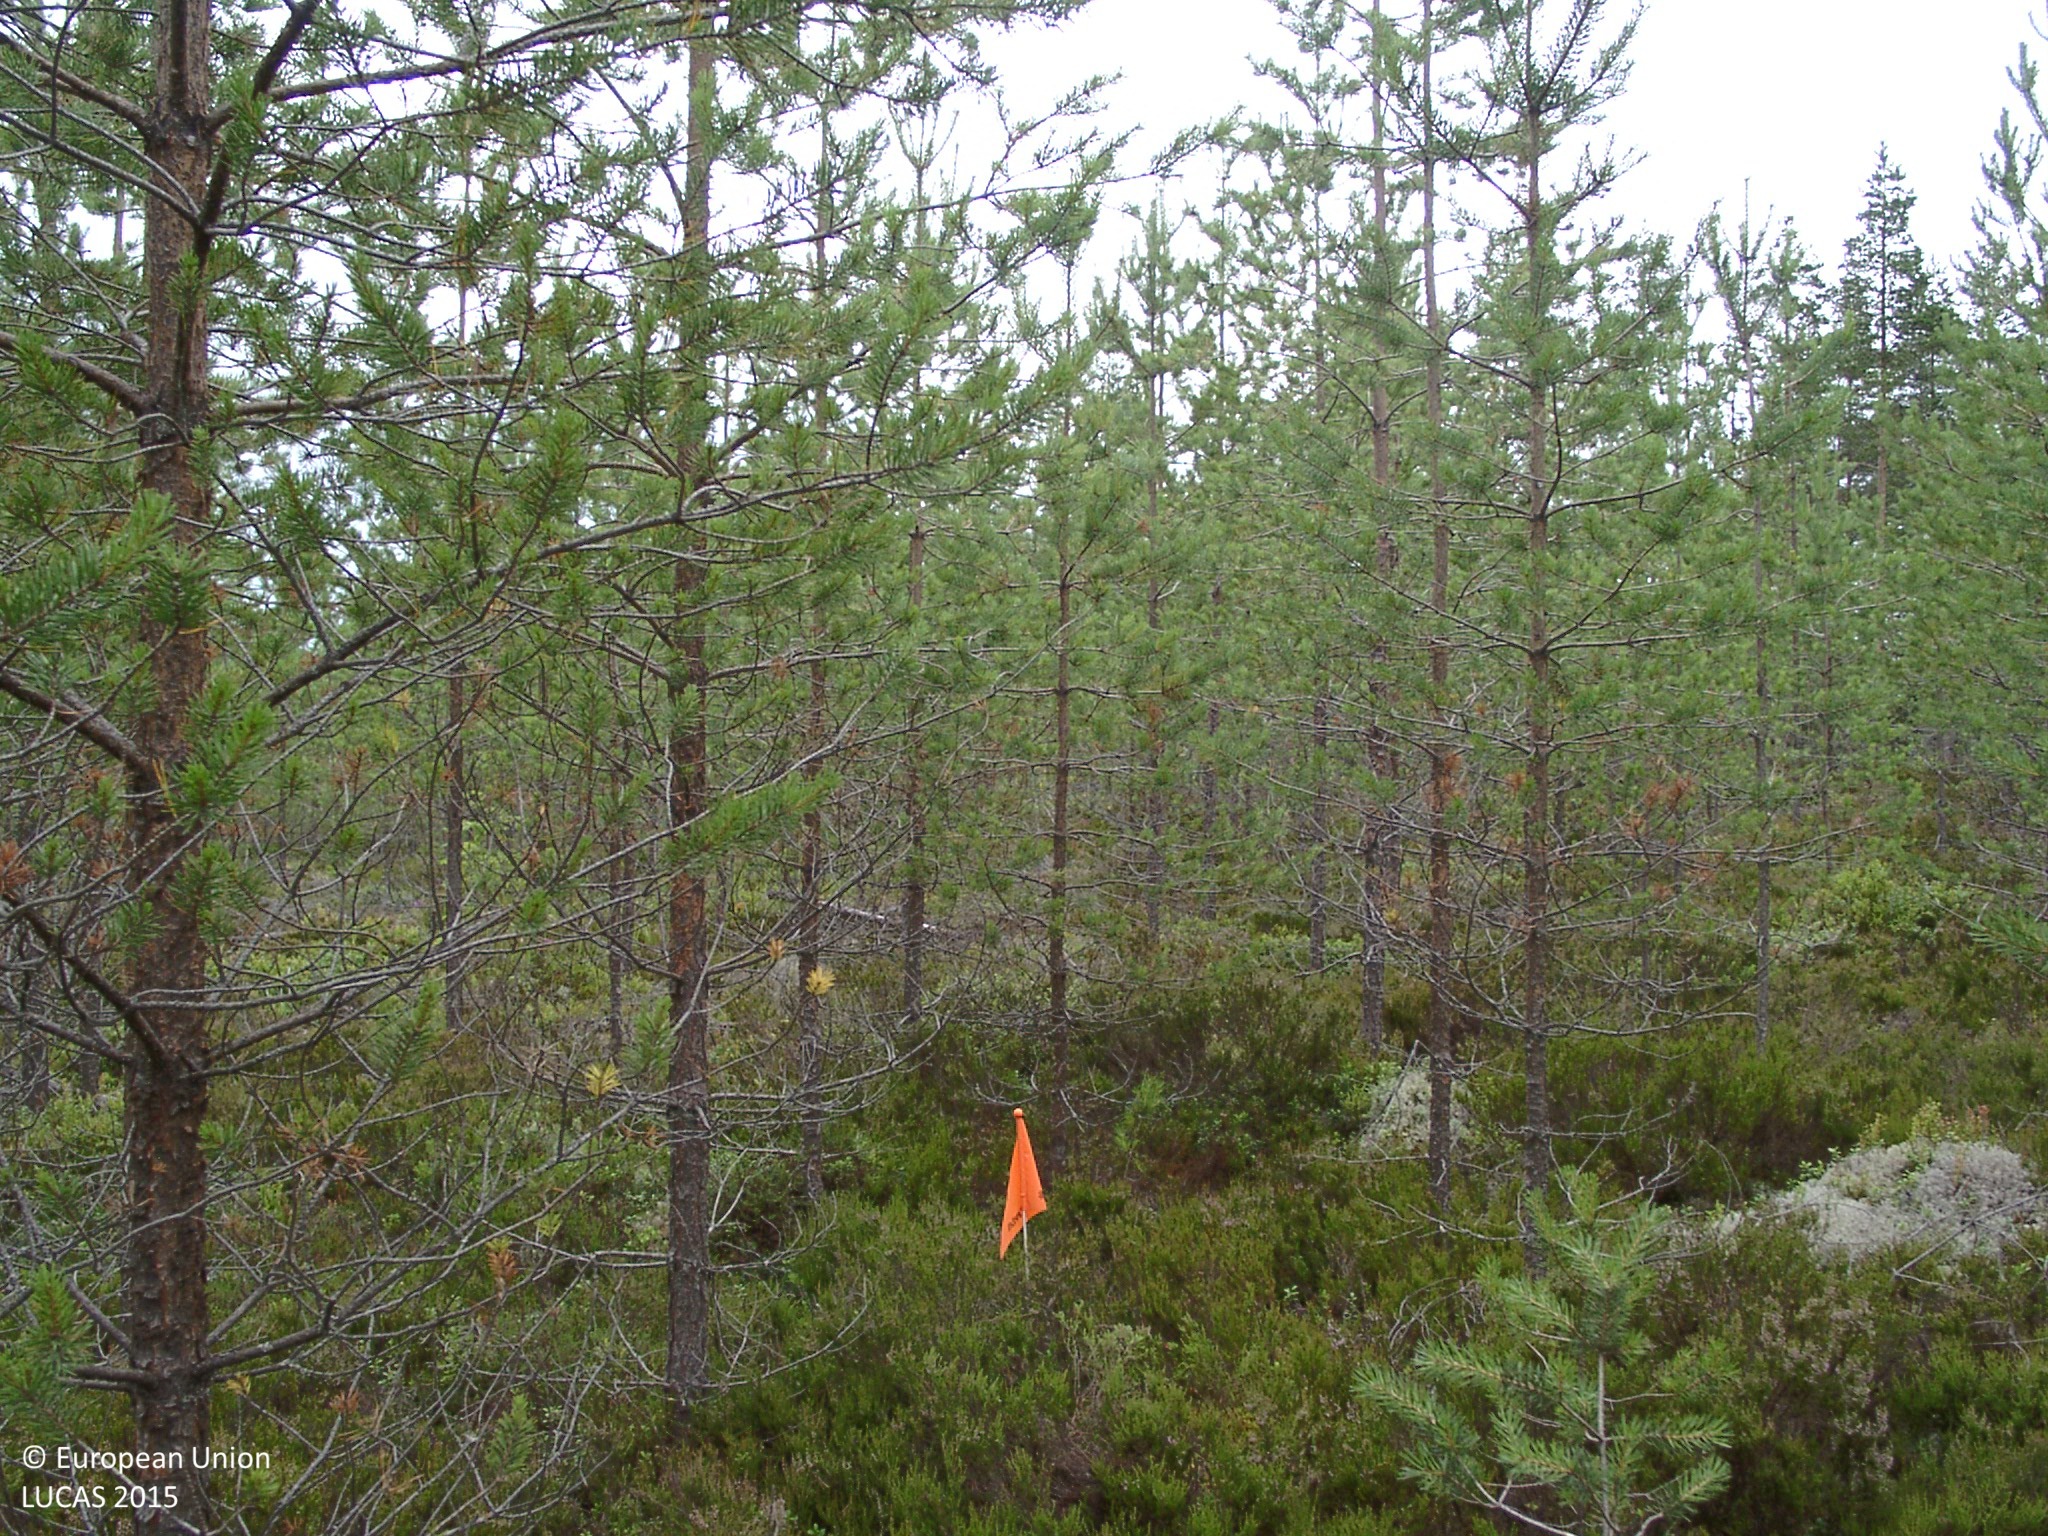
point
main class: Woodland
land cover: Pine dominated coniferous woodland
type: boreal forest
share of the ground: 50 - 75 %
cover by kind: coniferous forest trees 50 %, shrubs 35 %, lichens and mosses 15 %
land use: Forestry
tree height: < 5 m
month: July
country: FI
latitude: 62.7249
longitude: 24.5832
